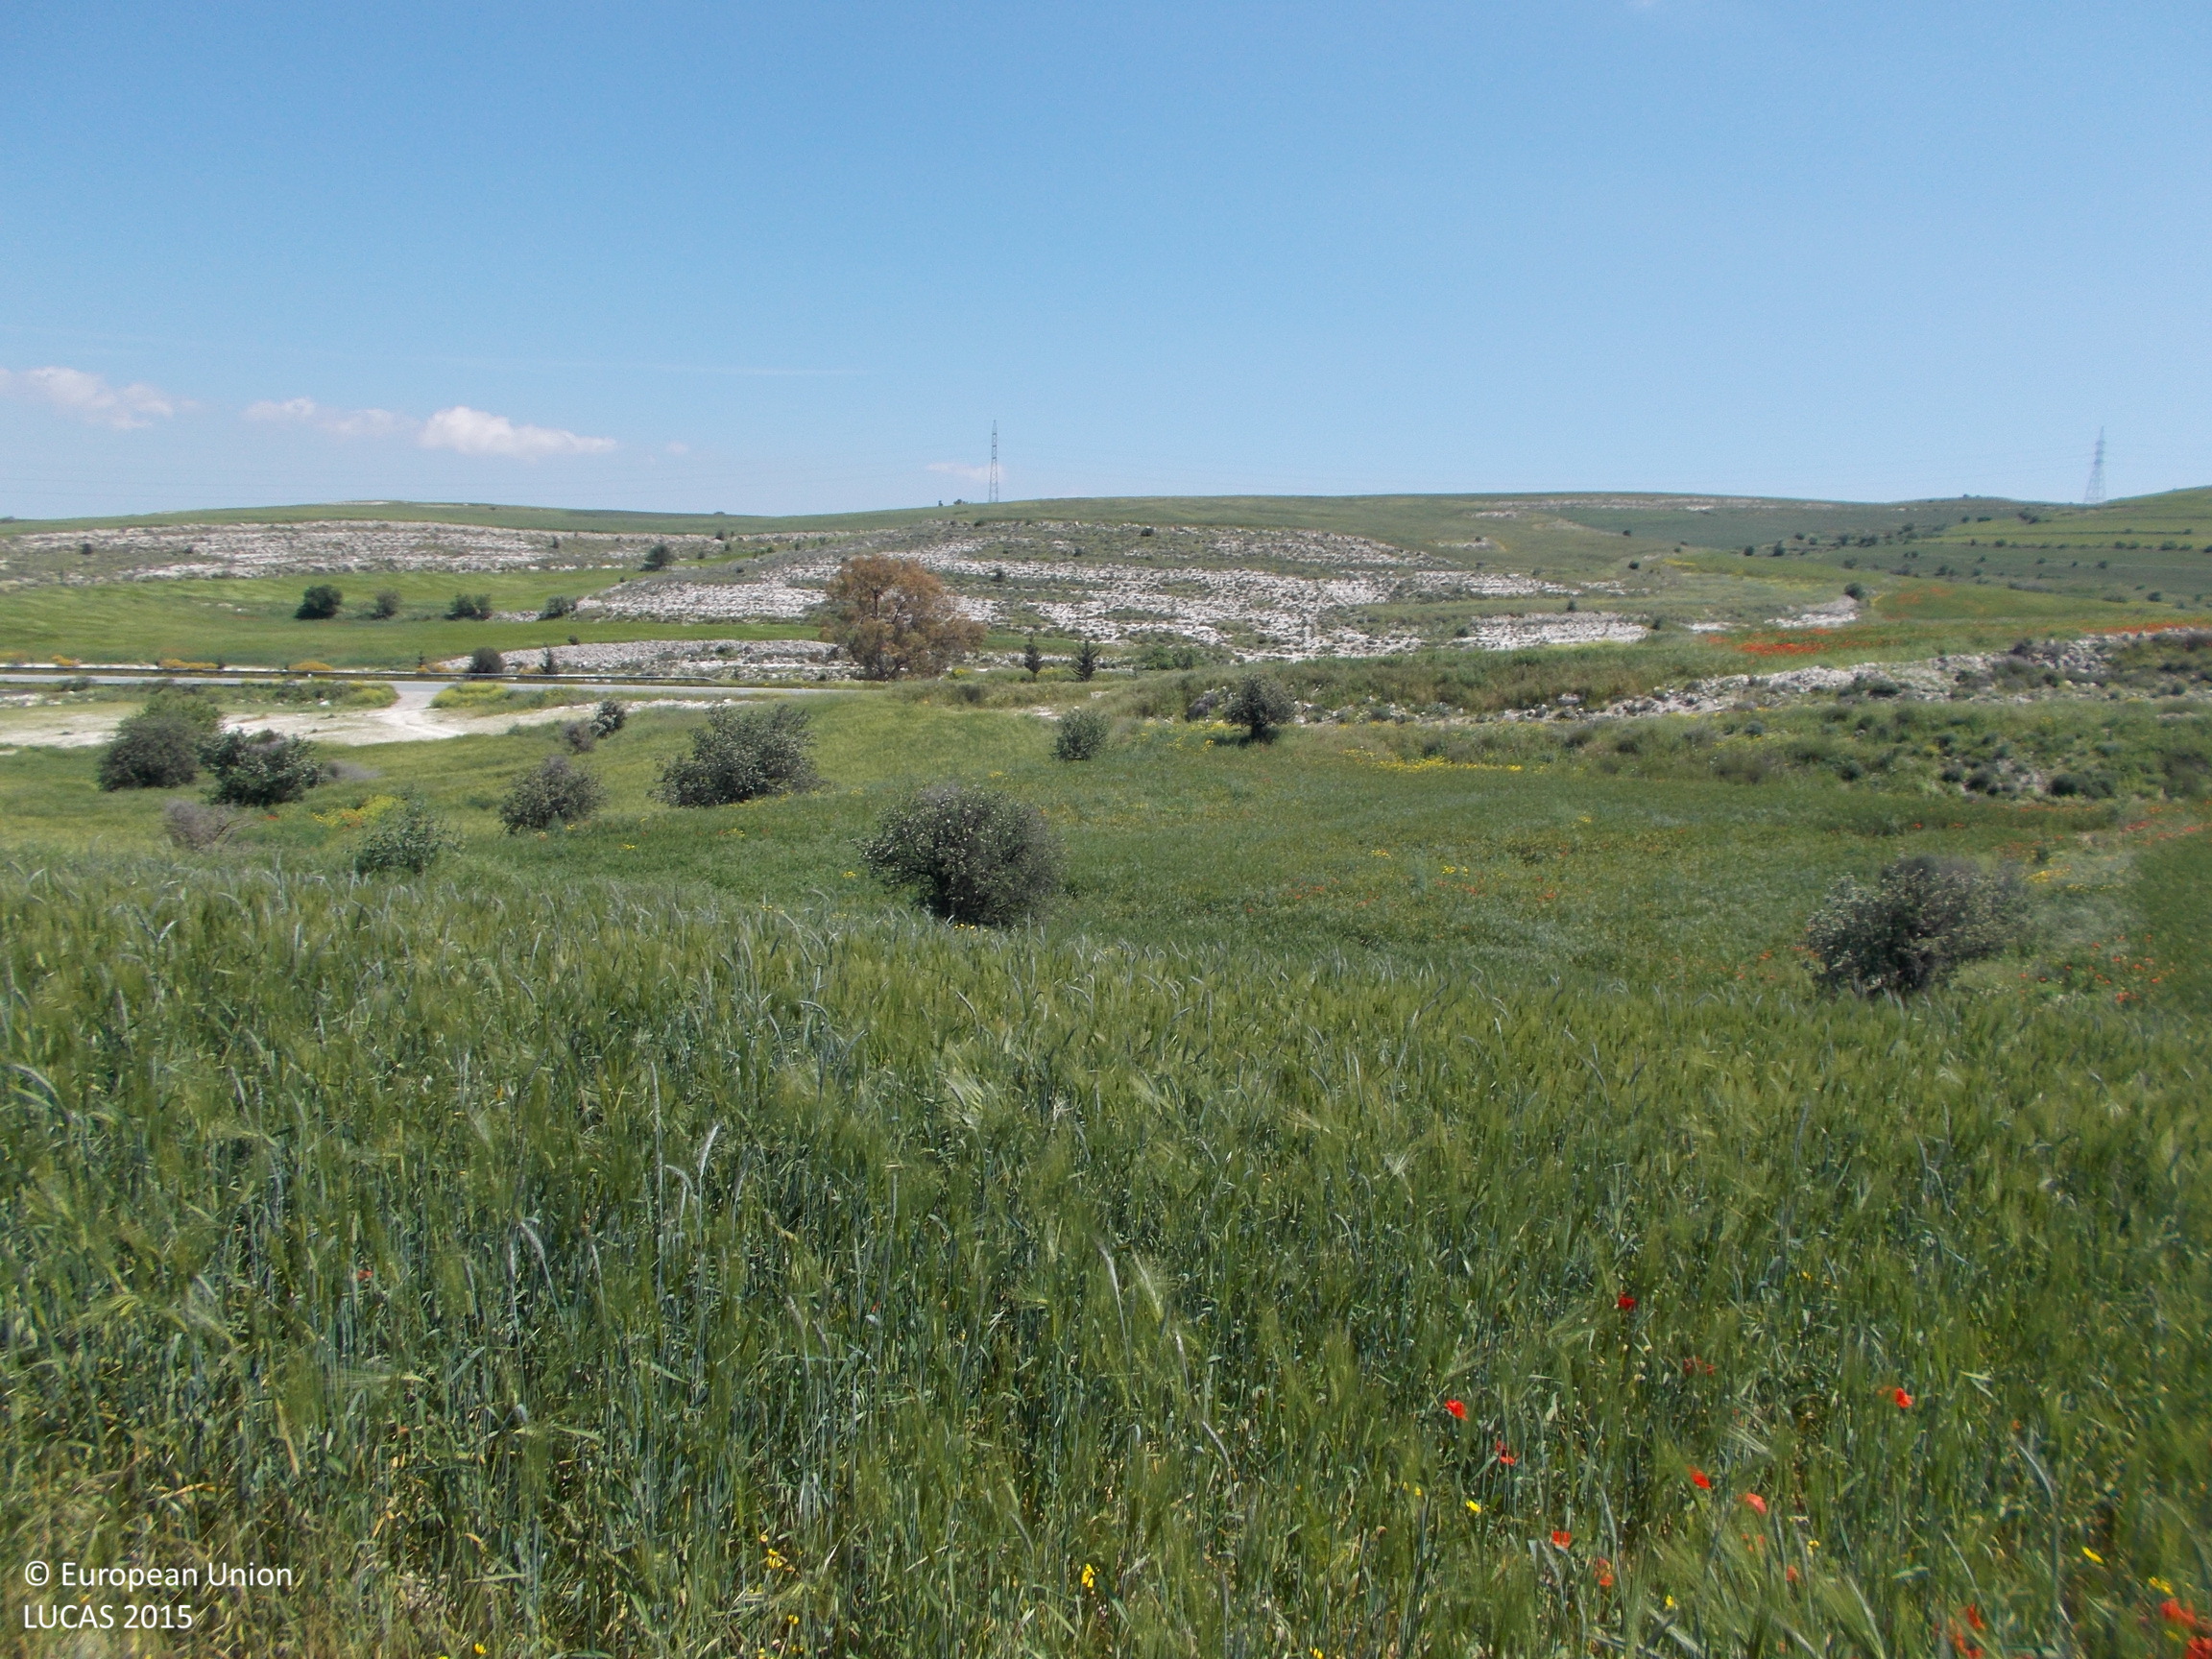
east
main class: Grassland
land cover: Grassland without tree/shrub cover
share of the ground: 25 - 50 %
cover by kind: herbaceous plants 50 %, consolidated bare surface 50 %
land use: Semi-natural and natural areas not in use
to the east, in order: Grassland without tree/shrub cover; Barley; Mixed cereals for fodder; Single bushes/trees; Spontaneously vegetated surfaces; Tracks; Grass margins; Shrubland without tree cover; Spontaneously vegetated surfaces; Rocks and stones; Abandoned hedges; Paved roads, cycling and walking lanes; Grassland with sparse tree/shrub cover; Lines of trees; Spontaneously vegetated surfaces; Shrubland without tree cover; Dry stone walls; Grassland without tree/shrub cover; Dry stone walls; Shrubland without tree cover; Rivers and streams; Single bushes/trees; Rivers and streams; Spontaneously vegetated surfaces; Rock outcrops; Tracks; Shrubland without tree cover; Barley; Shrubland without tree cover
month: April
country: CY
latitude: 35.0262
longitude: 33.5533
